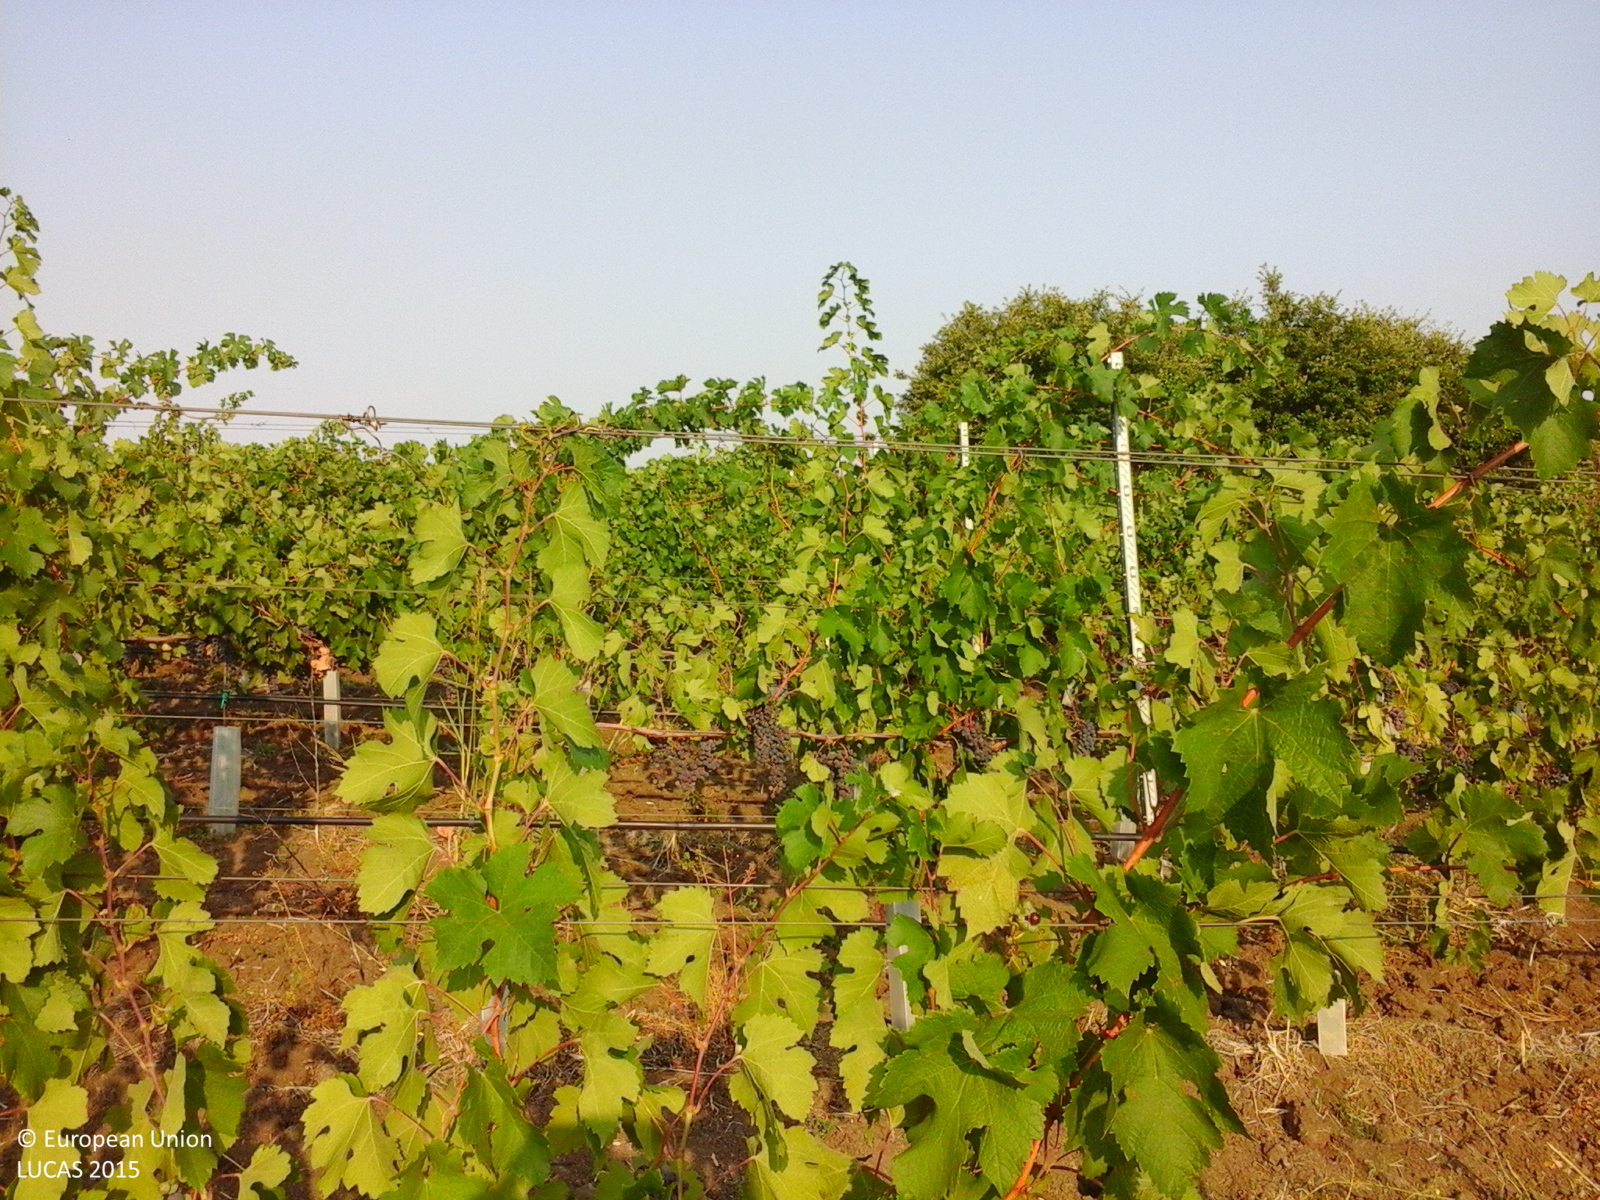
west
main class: Cropland
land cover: Vineyards
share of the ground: 25 - 50 %
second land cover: Other bare soil
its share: > 75 %
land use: Agriculture (excluding fallow land and kitchen gardens)
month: August
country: RO
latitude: 44.4921
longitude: 23.3172
